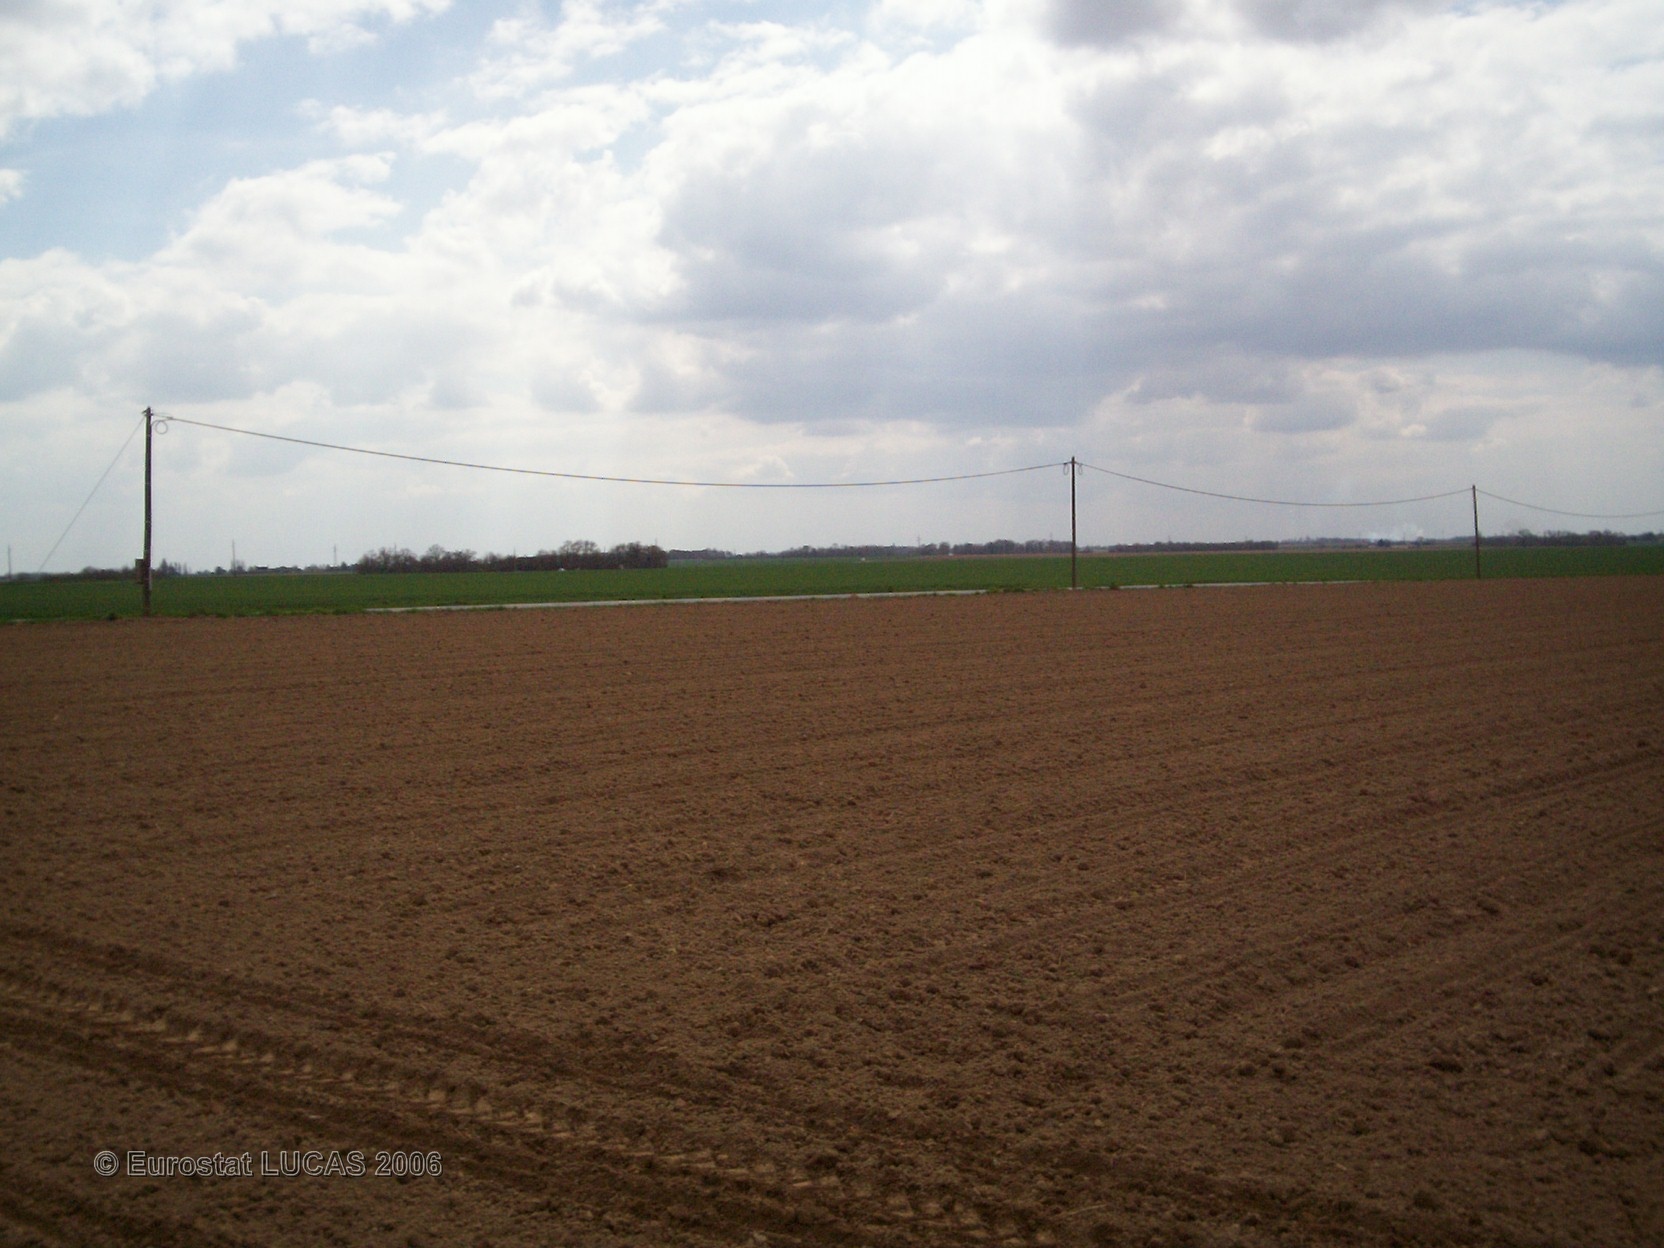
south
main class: Cropland
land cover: Maize
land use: Agriculture (excluding fallow land and kitchen gardens)
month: April
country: FR
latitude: 49.0887
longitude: 1.0369
